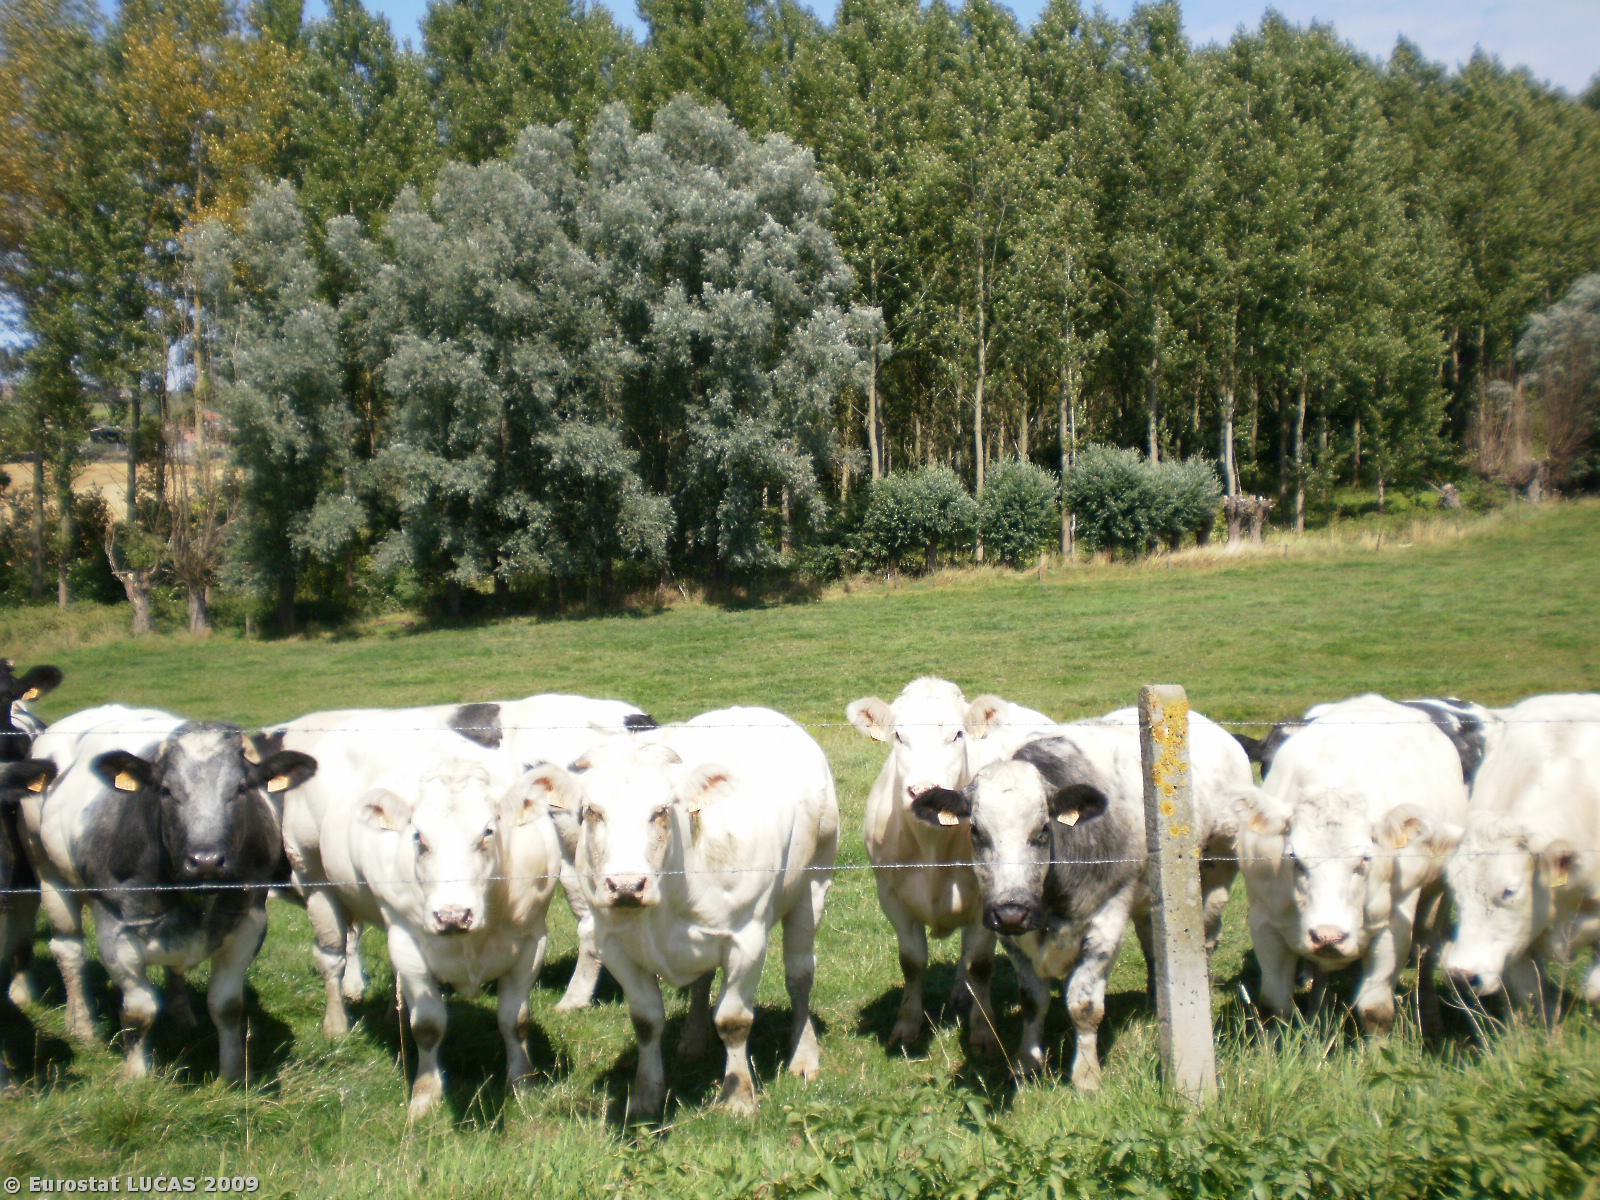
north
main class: Grassland
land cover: Grassland without tree/shrub cover
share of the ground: > 75 %
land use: Agriculture (excluding fallow land and kitchen gardens)
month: August
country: BE
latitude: 50.8265
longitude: 3.7894
